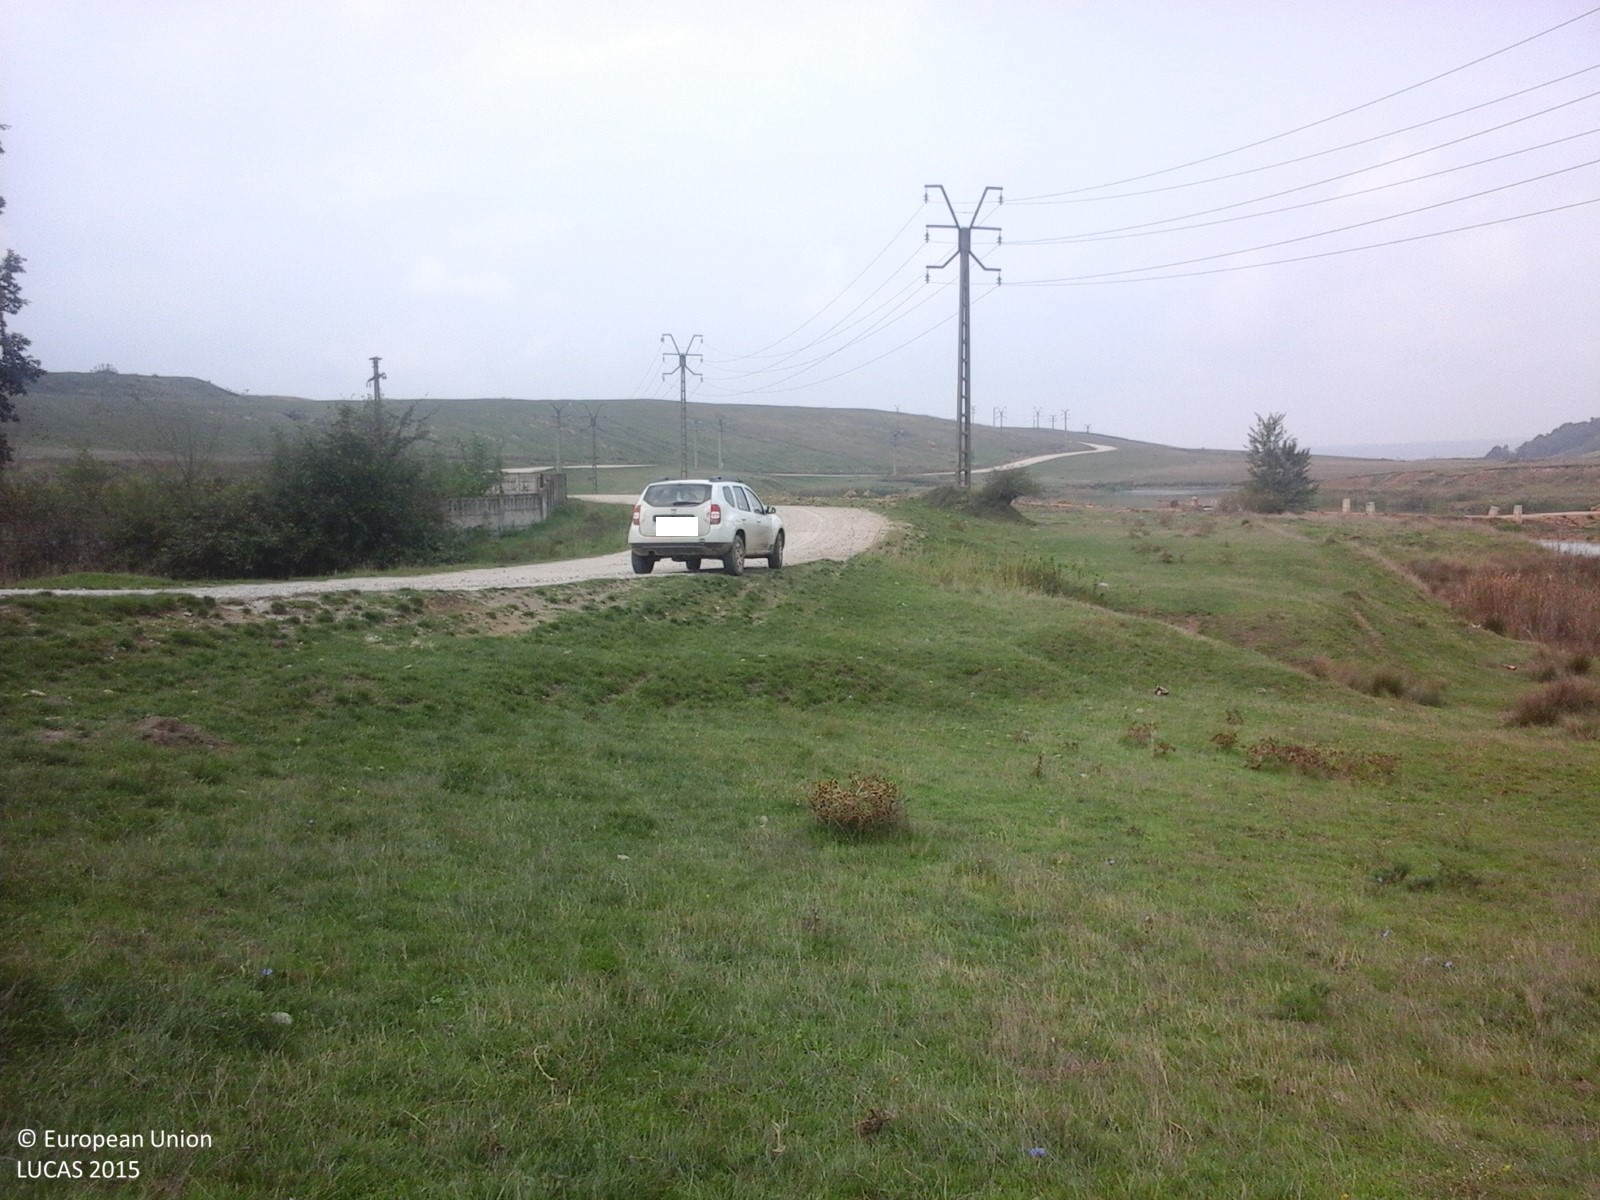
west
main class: Grassland
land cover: Grassland without tree/shrub cover
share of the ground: > 75 %
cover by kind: herbaceous plants 100 %
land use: Agriculture (excluding fallow land and kitchen gardens)
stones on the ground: < 10 %
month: September
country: RO
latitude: 44.9407
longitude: 23.0906
